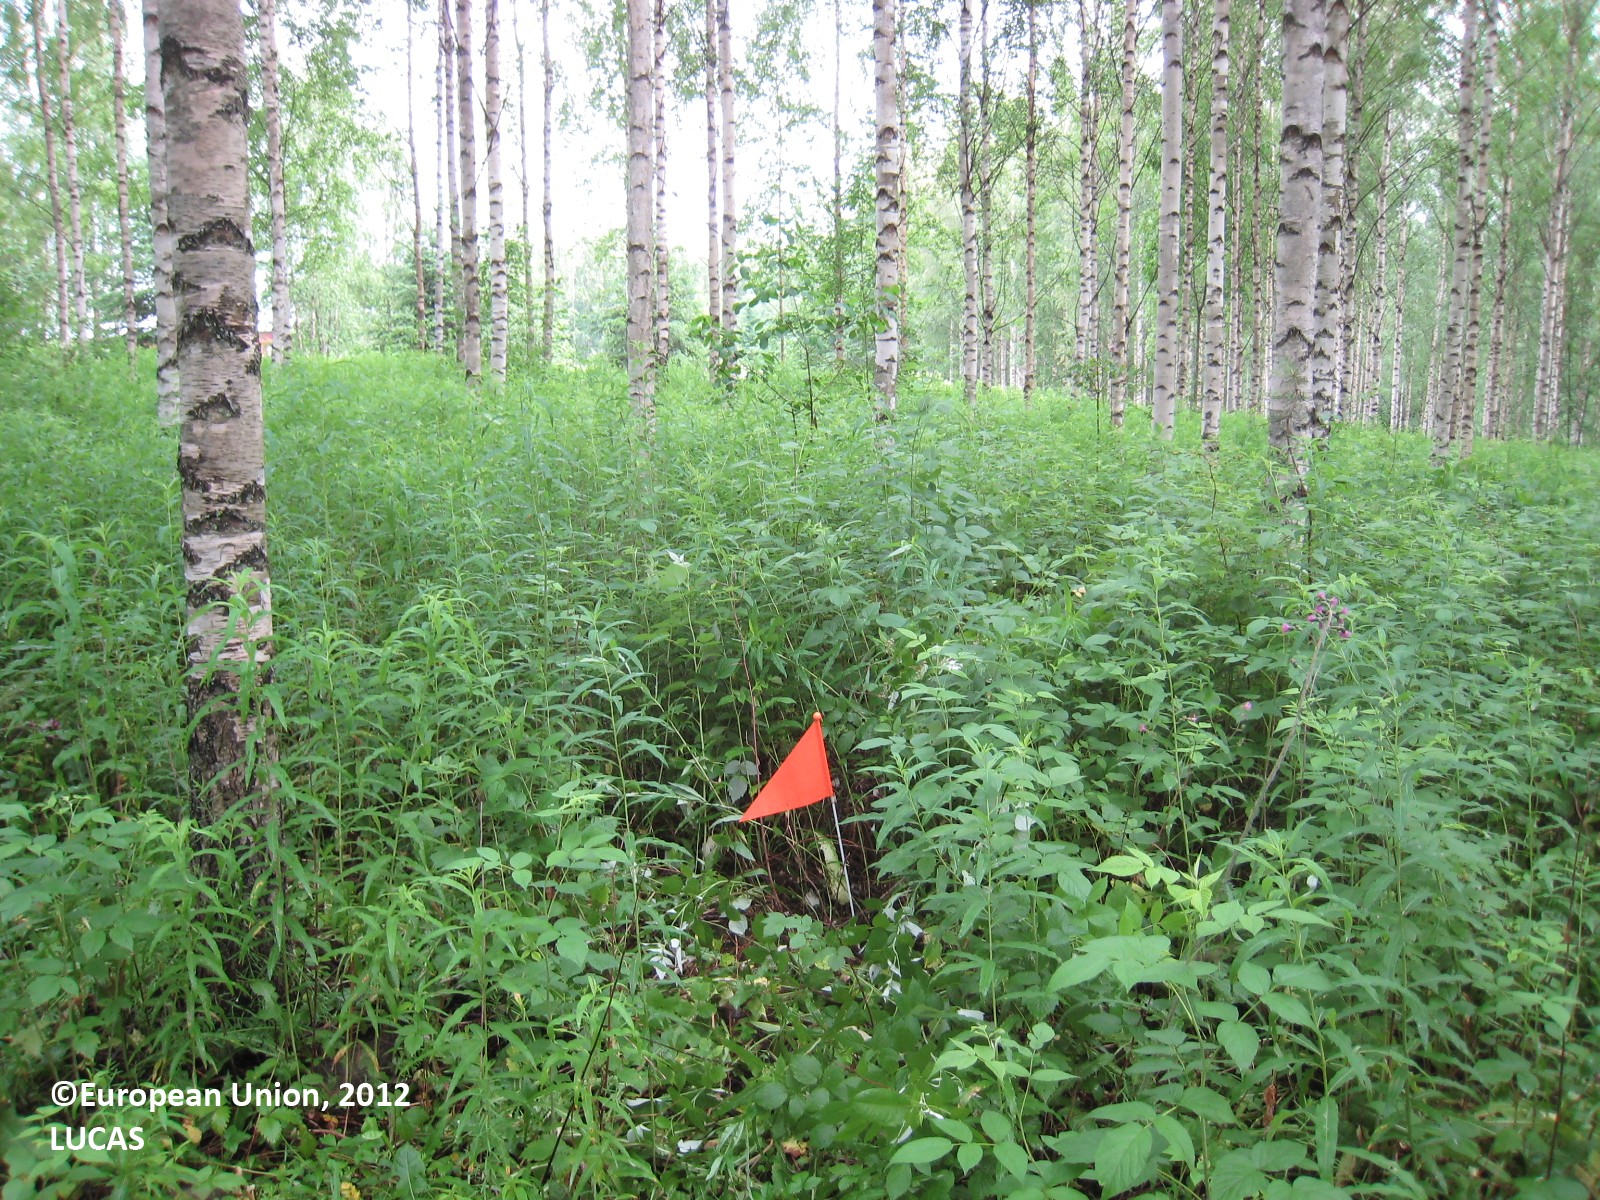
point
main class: Woodland
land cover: Broadleaved woodland
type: non-riverine alder, birch or aspen forest
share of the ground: > 75 %
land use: Forestry
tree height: > 5 m
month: July
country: FI
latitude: 61.8067
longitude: 26.9492
